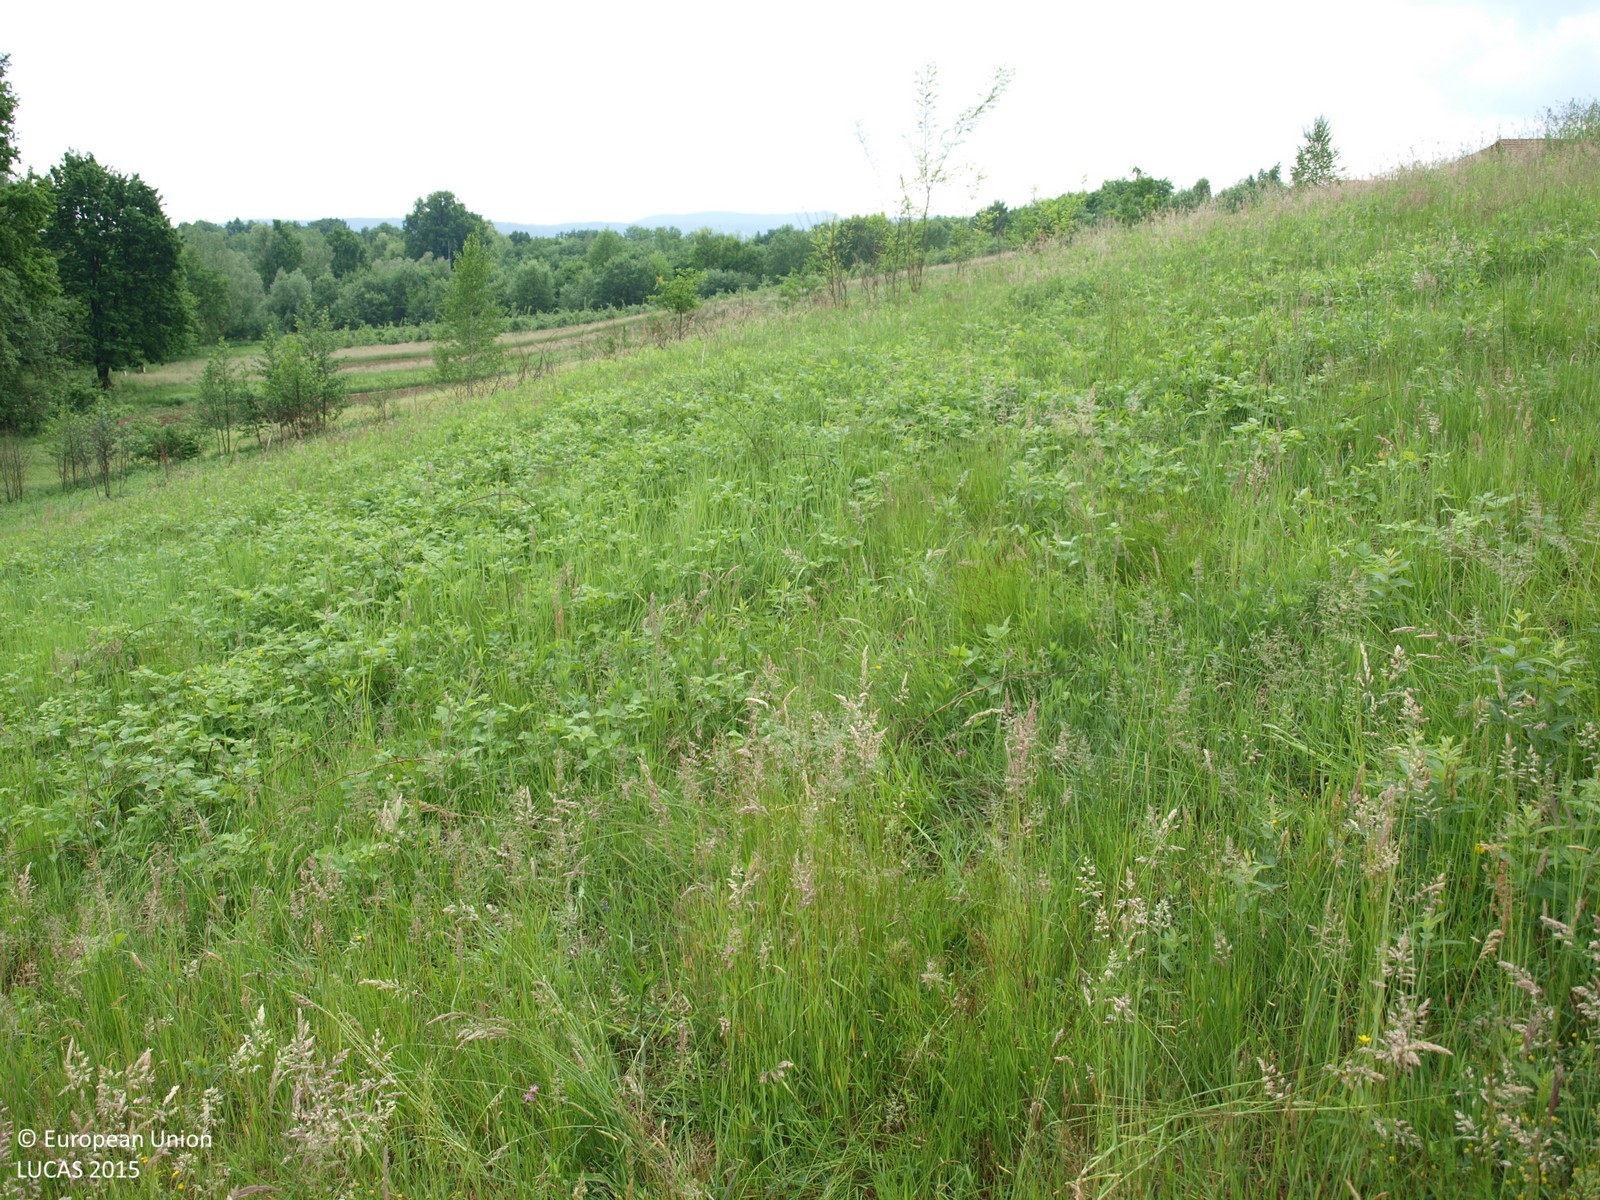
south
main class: Grassland
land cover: Grassland without tree/shrub cover
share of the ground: > 75 %
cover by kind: herbaceous plants 100 %
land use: Agriculture (excluding fallow land and kitchen gardens)
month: May
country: HR
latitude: 46.0650
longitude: 16.1655
